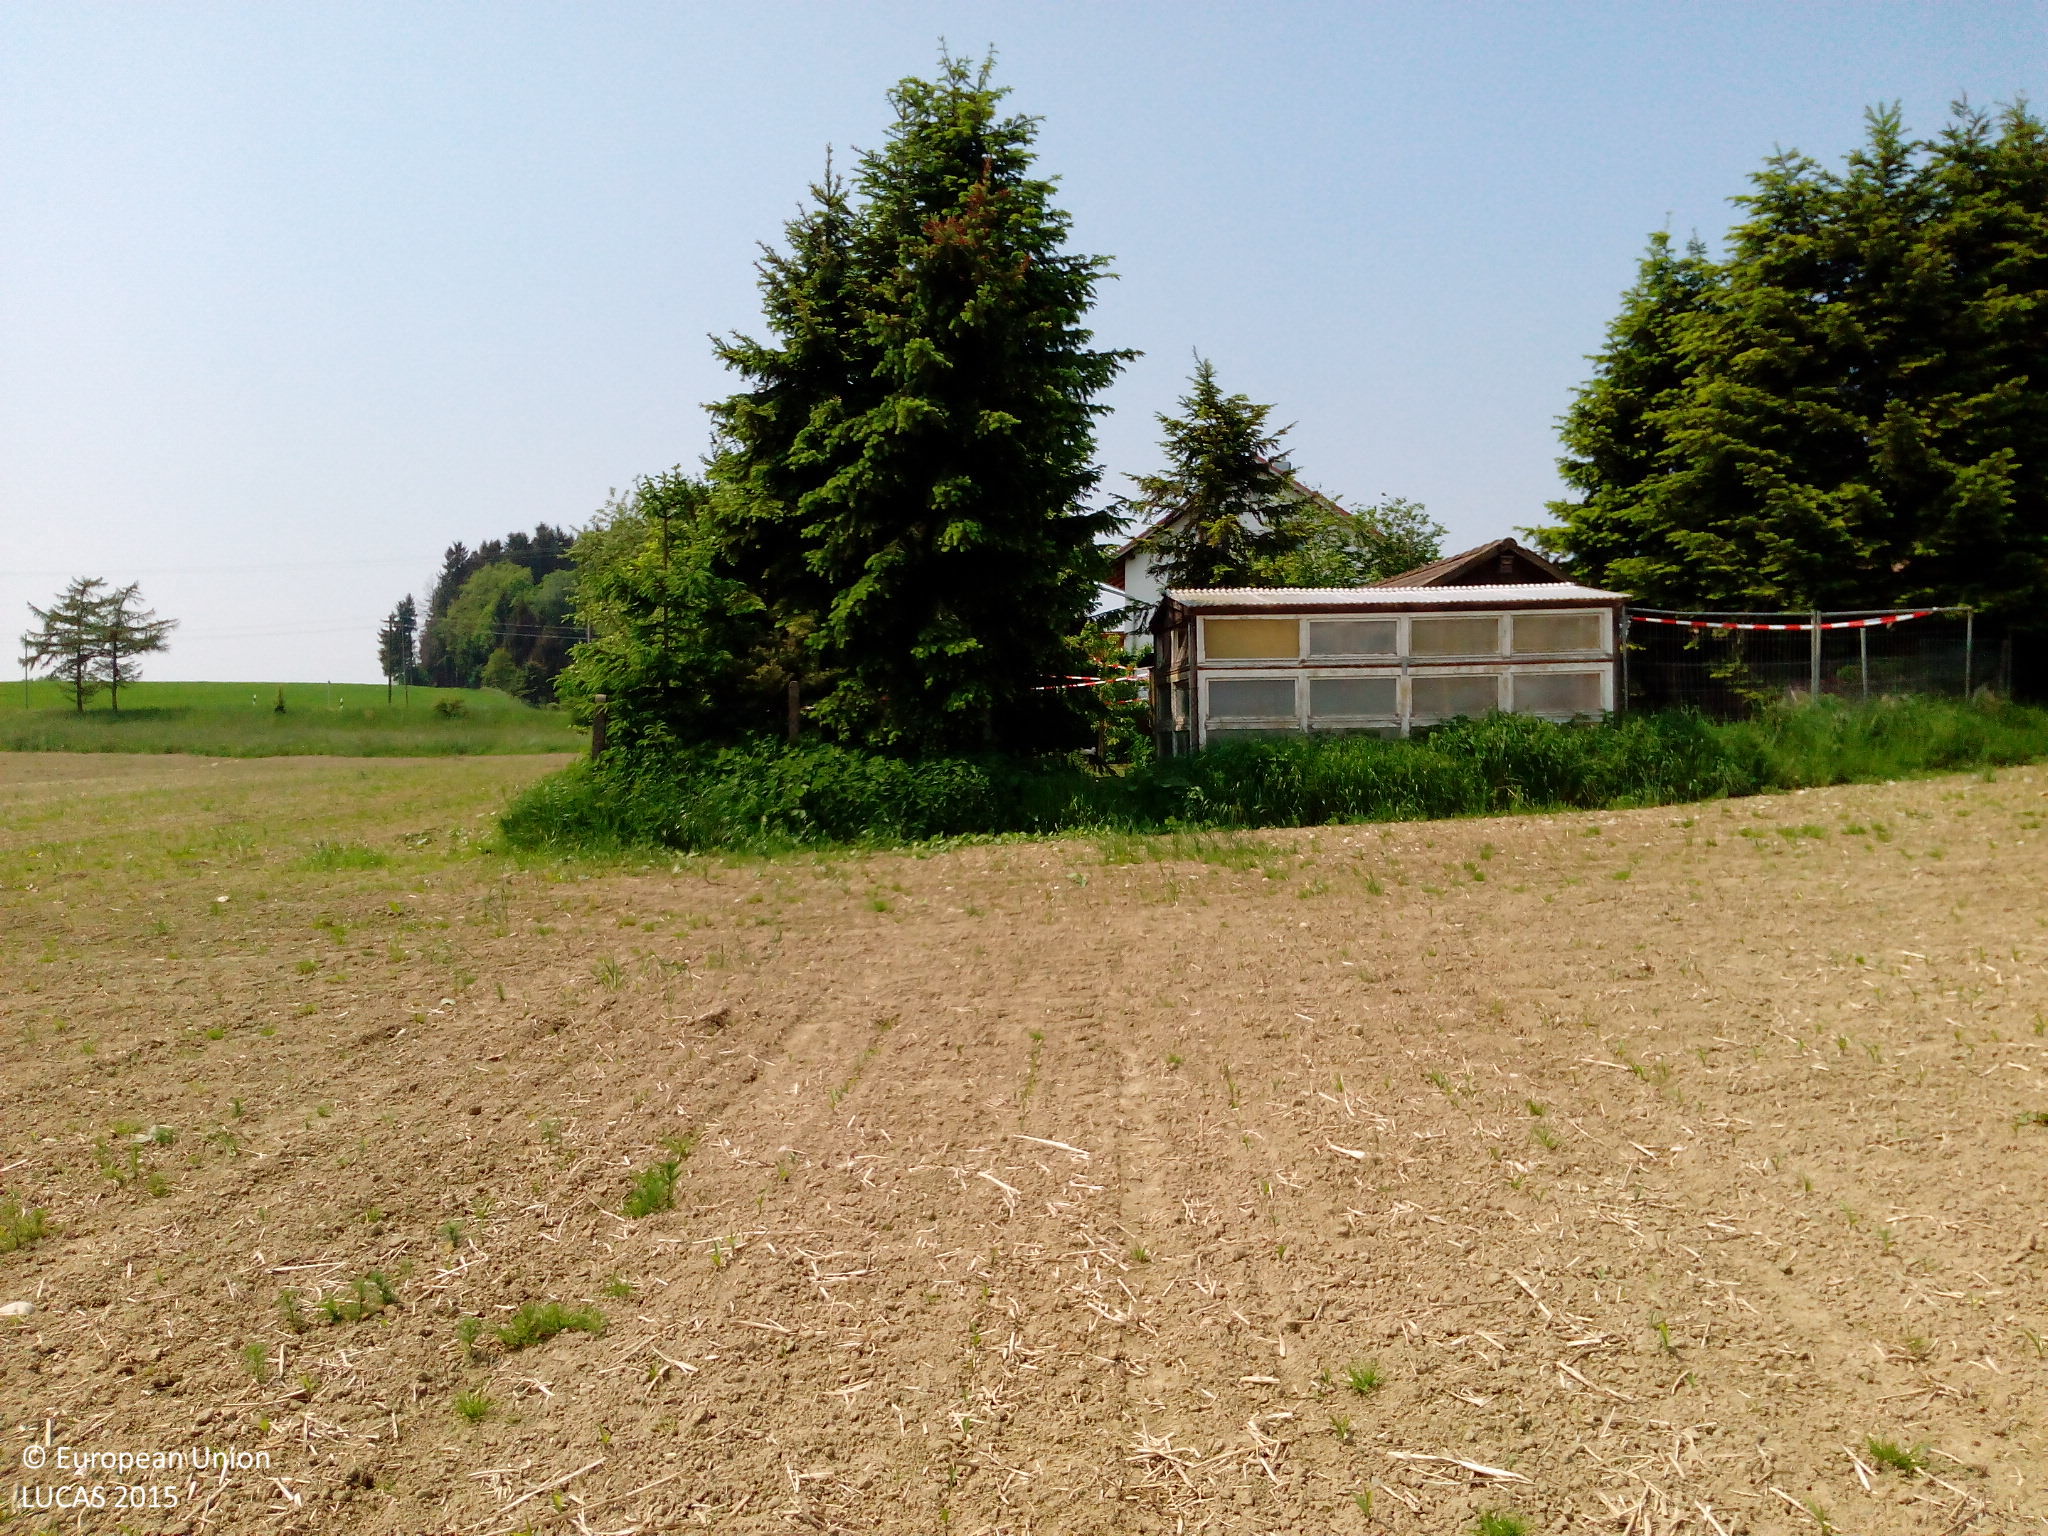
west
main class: Cropland
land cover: Maize
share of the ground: < 10 %
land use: Agriculture (excluding fallow land and kitchen gardens)
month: May
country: DE
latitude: 48.2948
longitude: 12.0344
